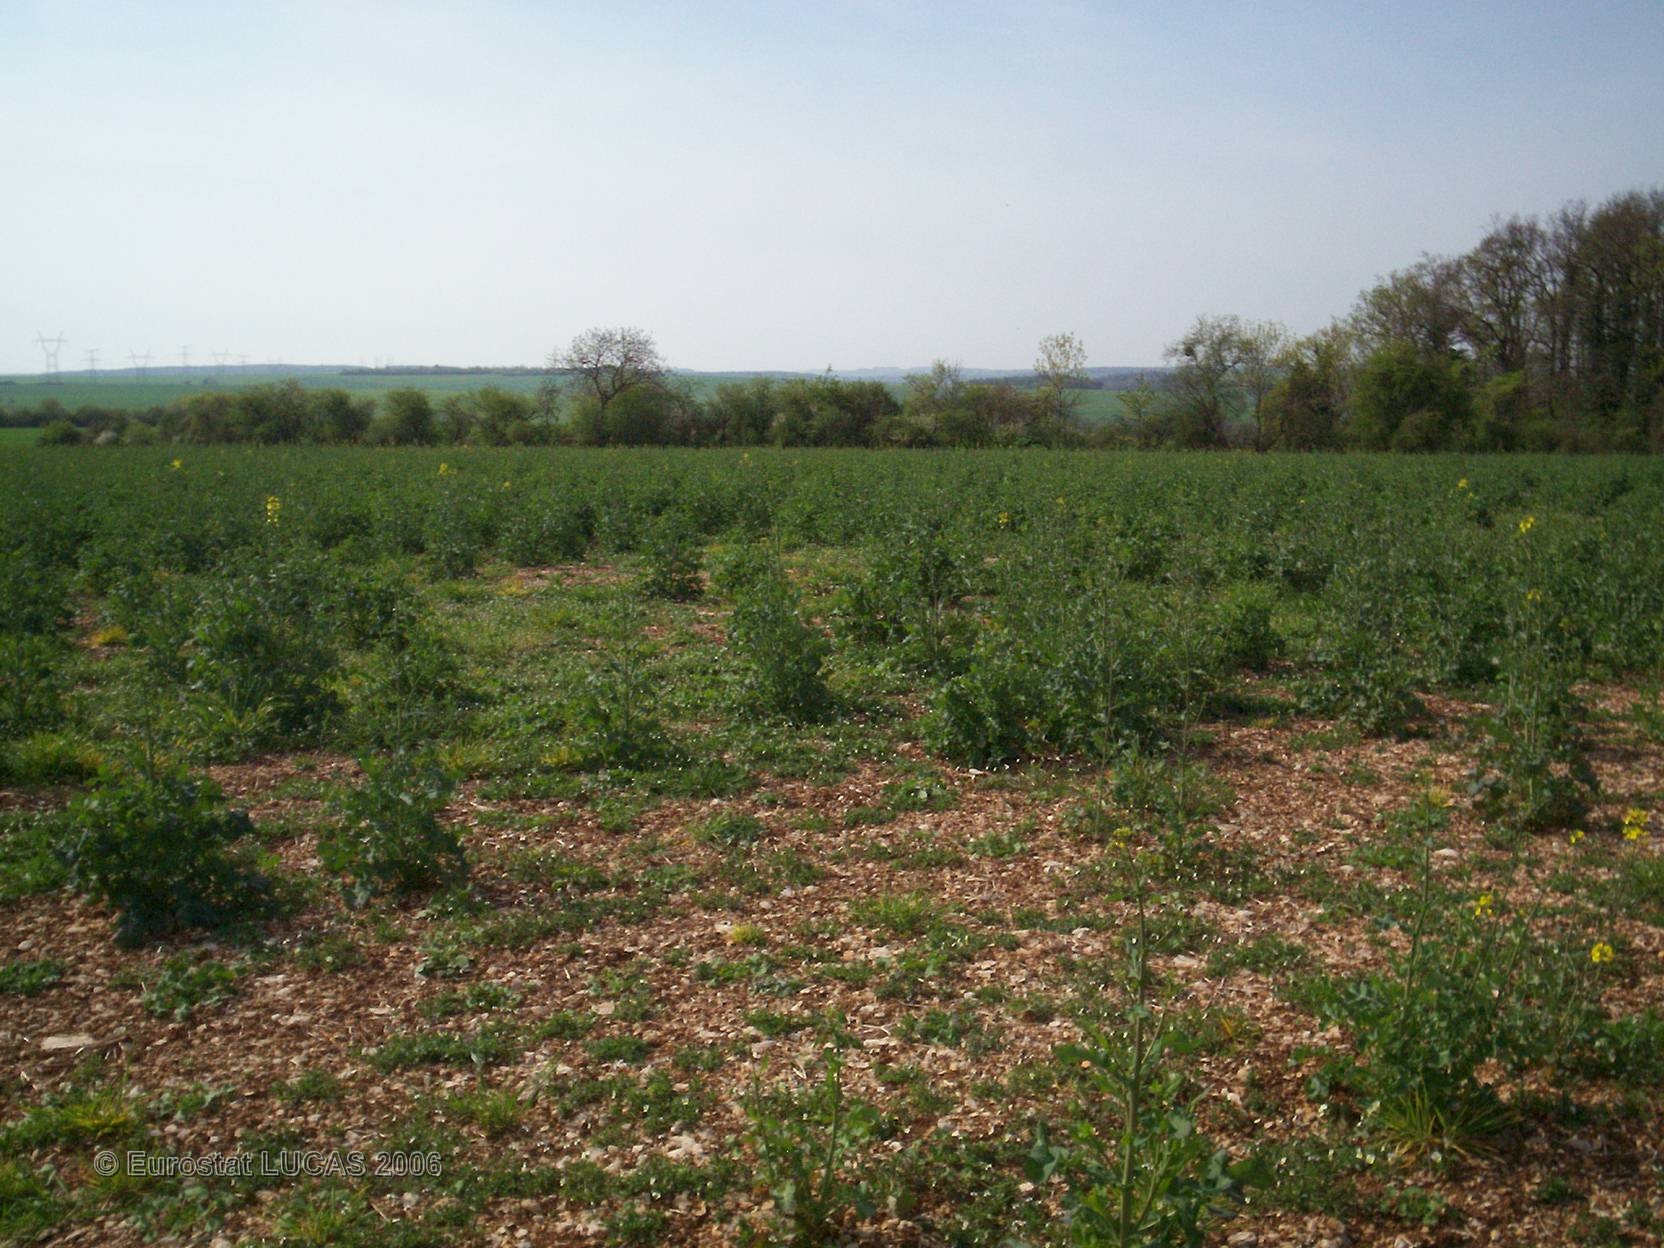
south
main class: Cropland
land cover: Rape and turnip rape
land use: Agriculture (excluding fallow land and kitchen gardens)
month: May
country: FR
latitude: 47.5843
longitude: 4.5608
